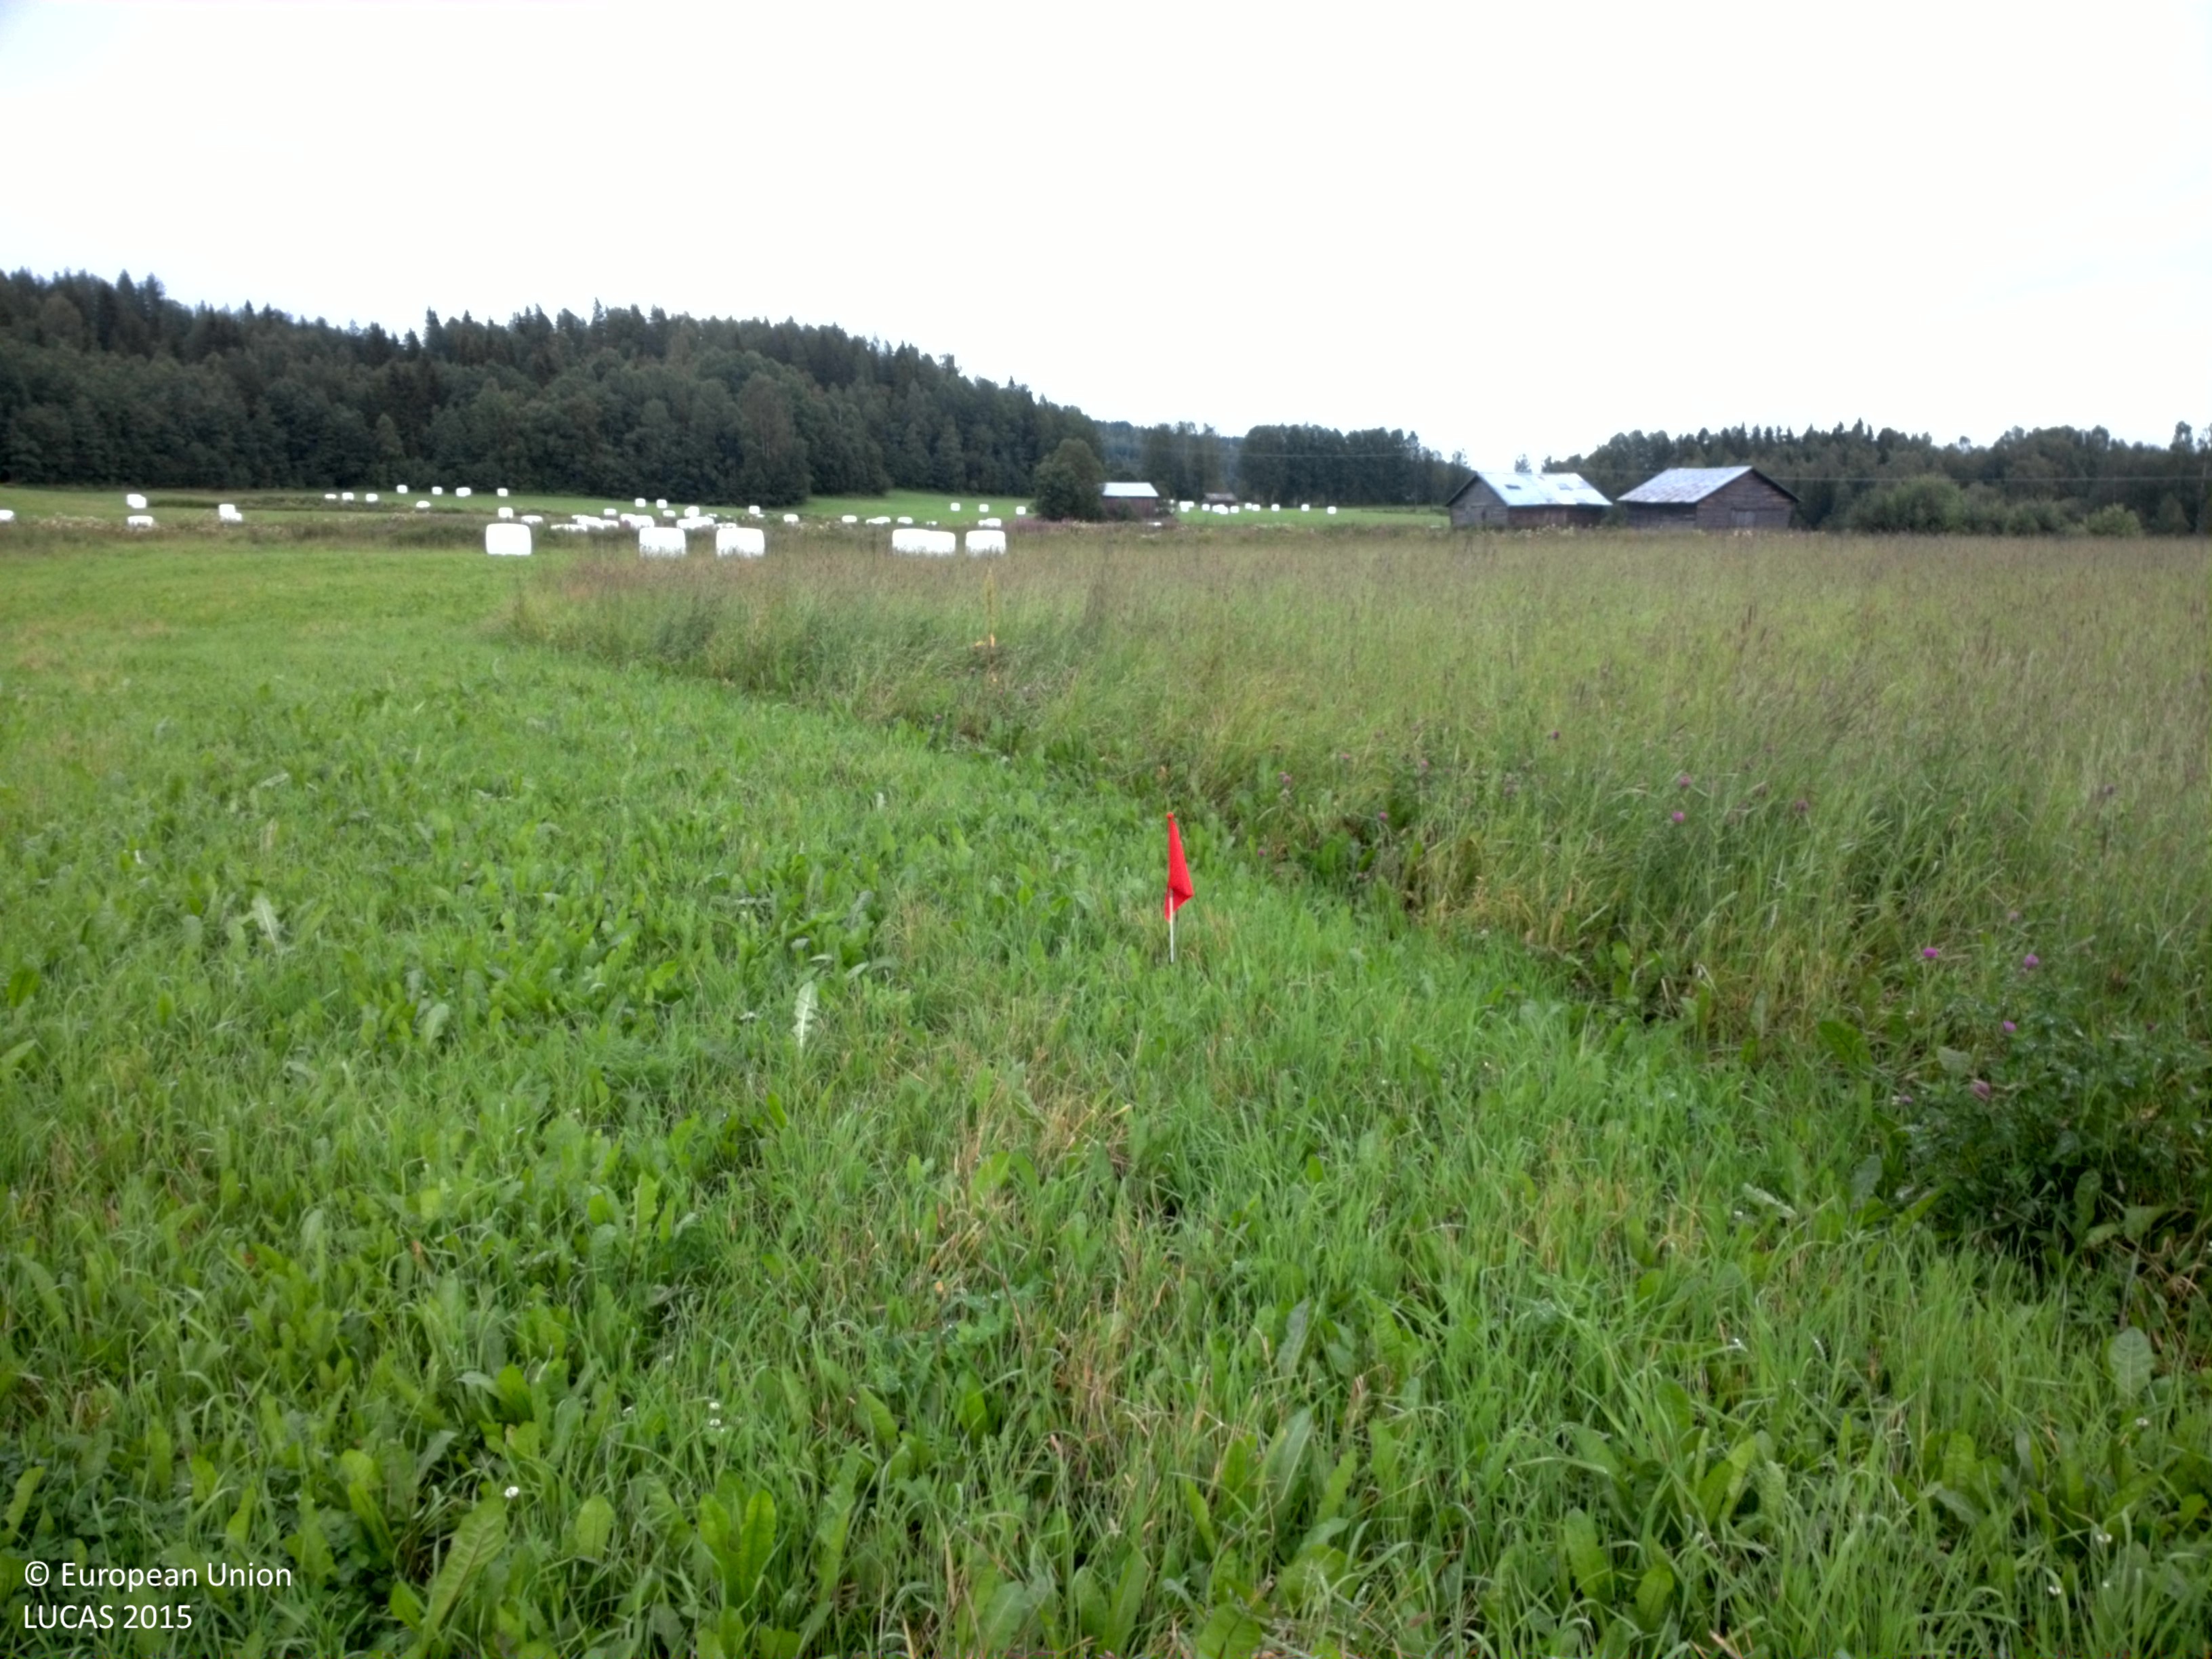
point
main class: Grassland
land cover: Grassland without tree/shrub cover
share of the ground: > 75 %
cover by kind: herbaceous plants 100 %
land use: Agriculture (excluding fallow land and kitchen gardens)
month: August
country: SE
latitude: 64.7265
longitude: 20.7457
